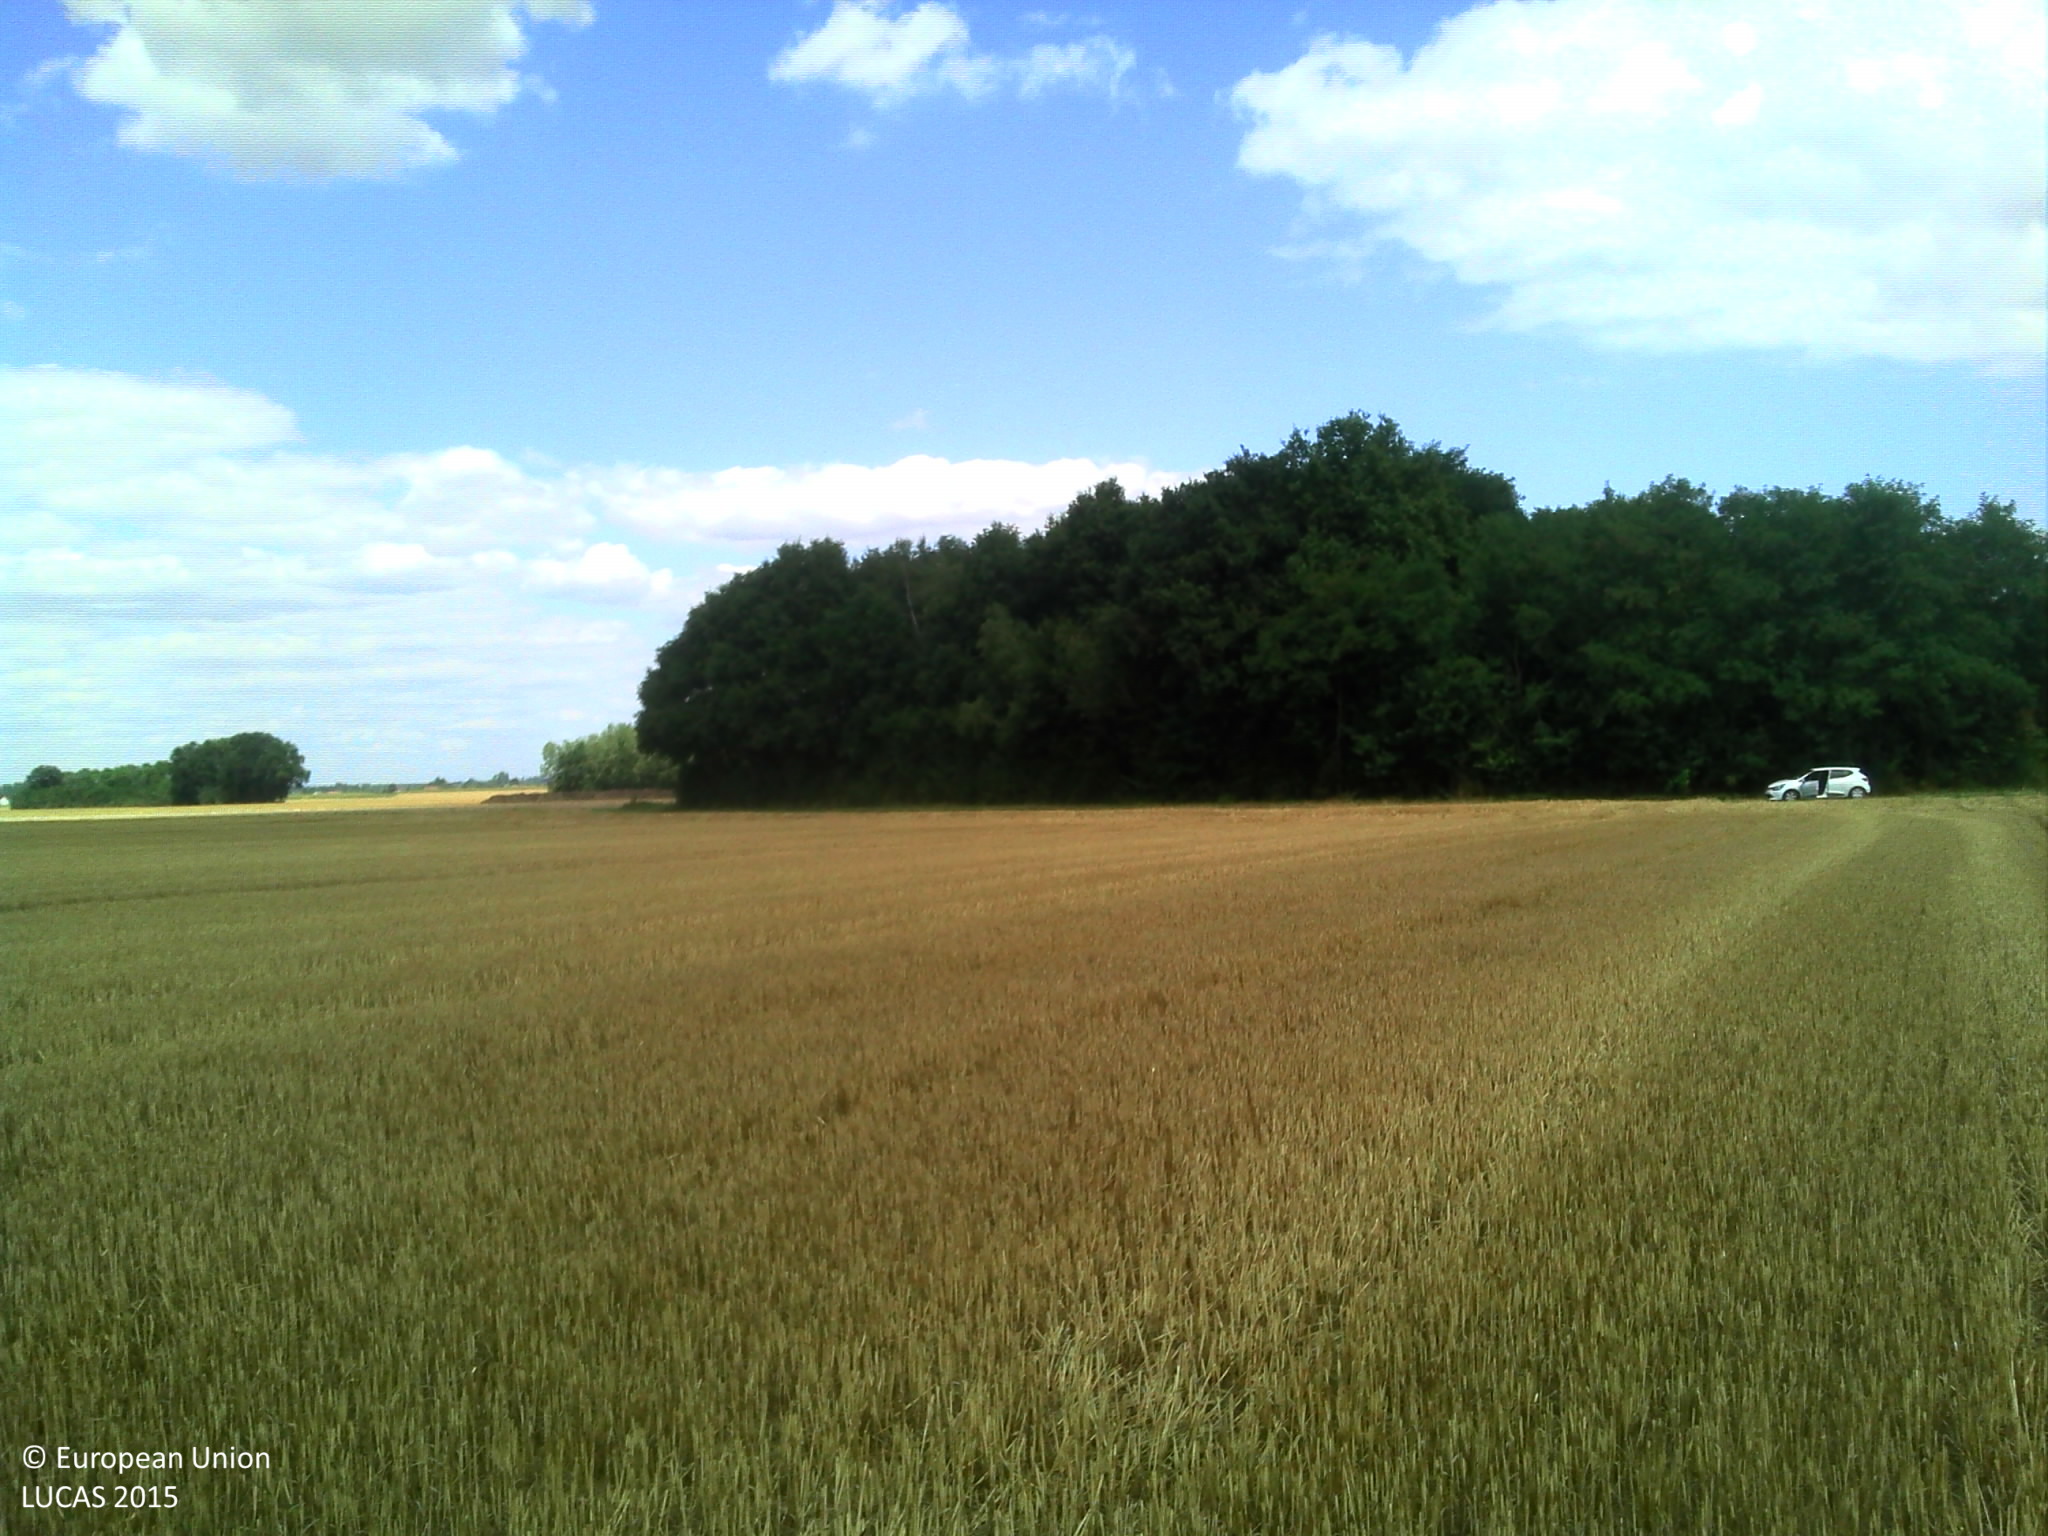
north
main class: Cropland
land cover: Common wheat
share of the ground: > 75 %
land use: Agriculture (excluding fallow land and kitchen gardens)
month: July
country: FR
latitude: 46.6814
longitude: 4.9159
